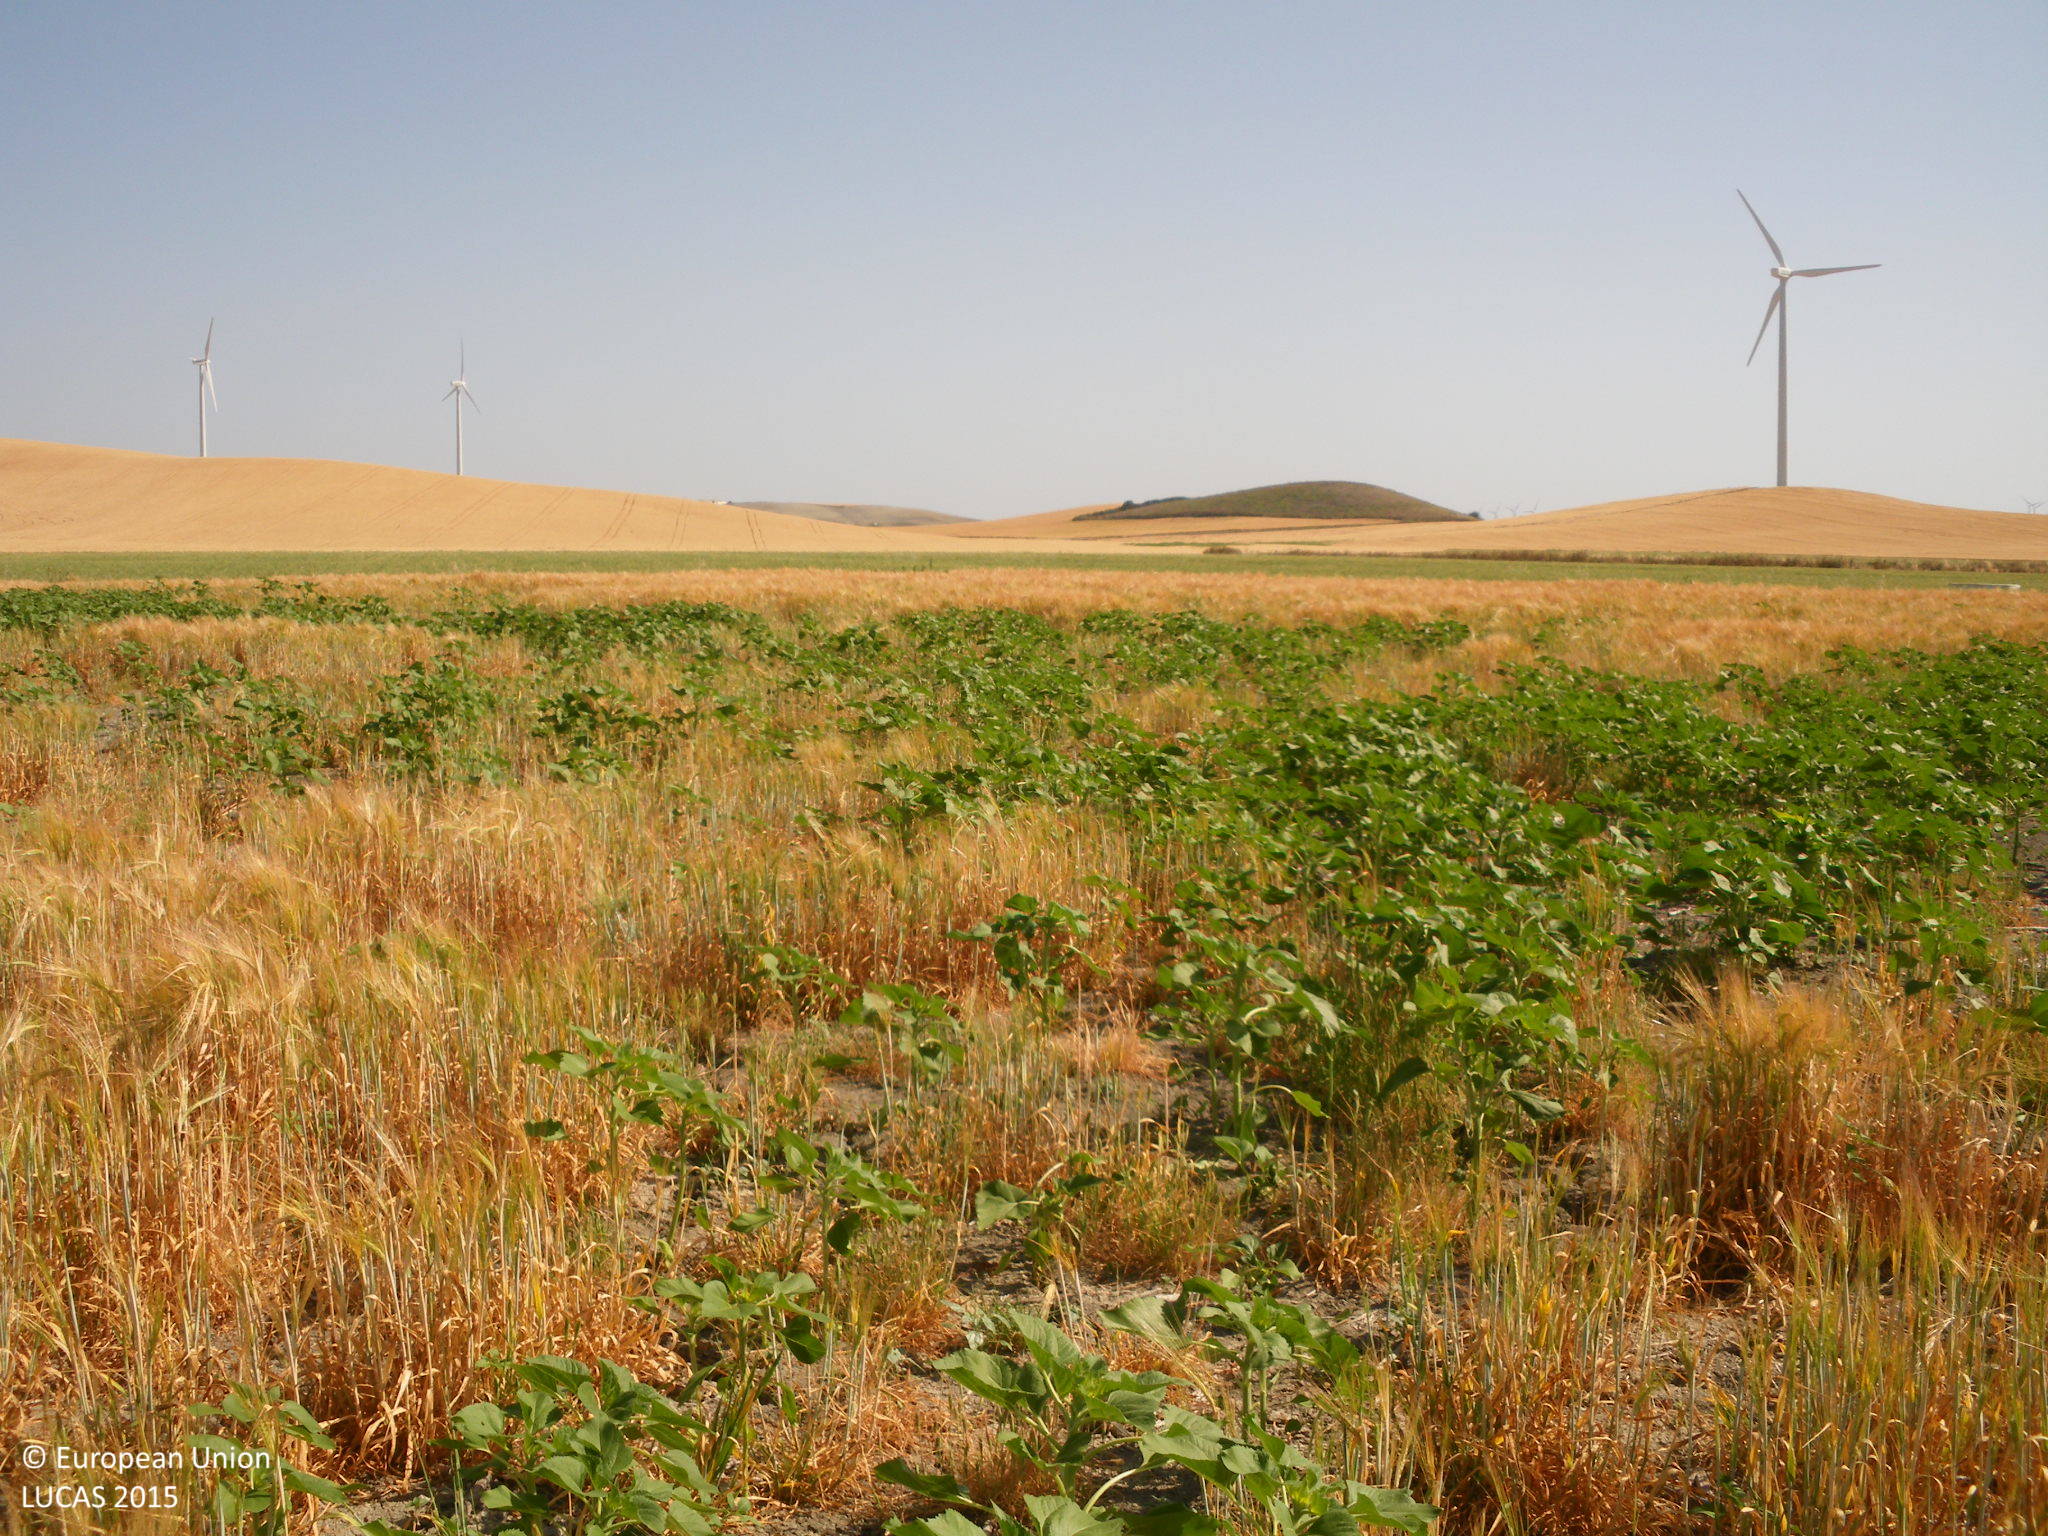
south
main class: Cropland
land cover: Barley
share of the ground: 50 - 75 %
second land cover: Sunflower
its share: < 10 %
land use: Agriculture (excluding fallow land and kitchen gardens)
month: May
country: ES
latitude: 36.7822
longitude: -6.2523
